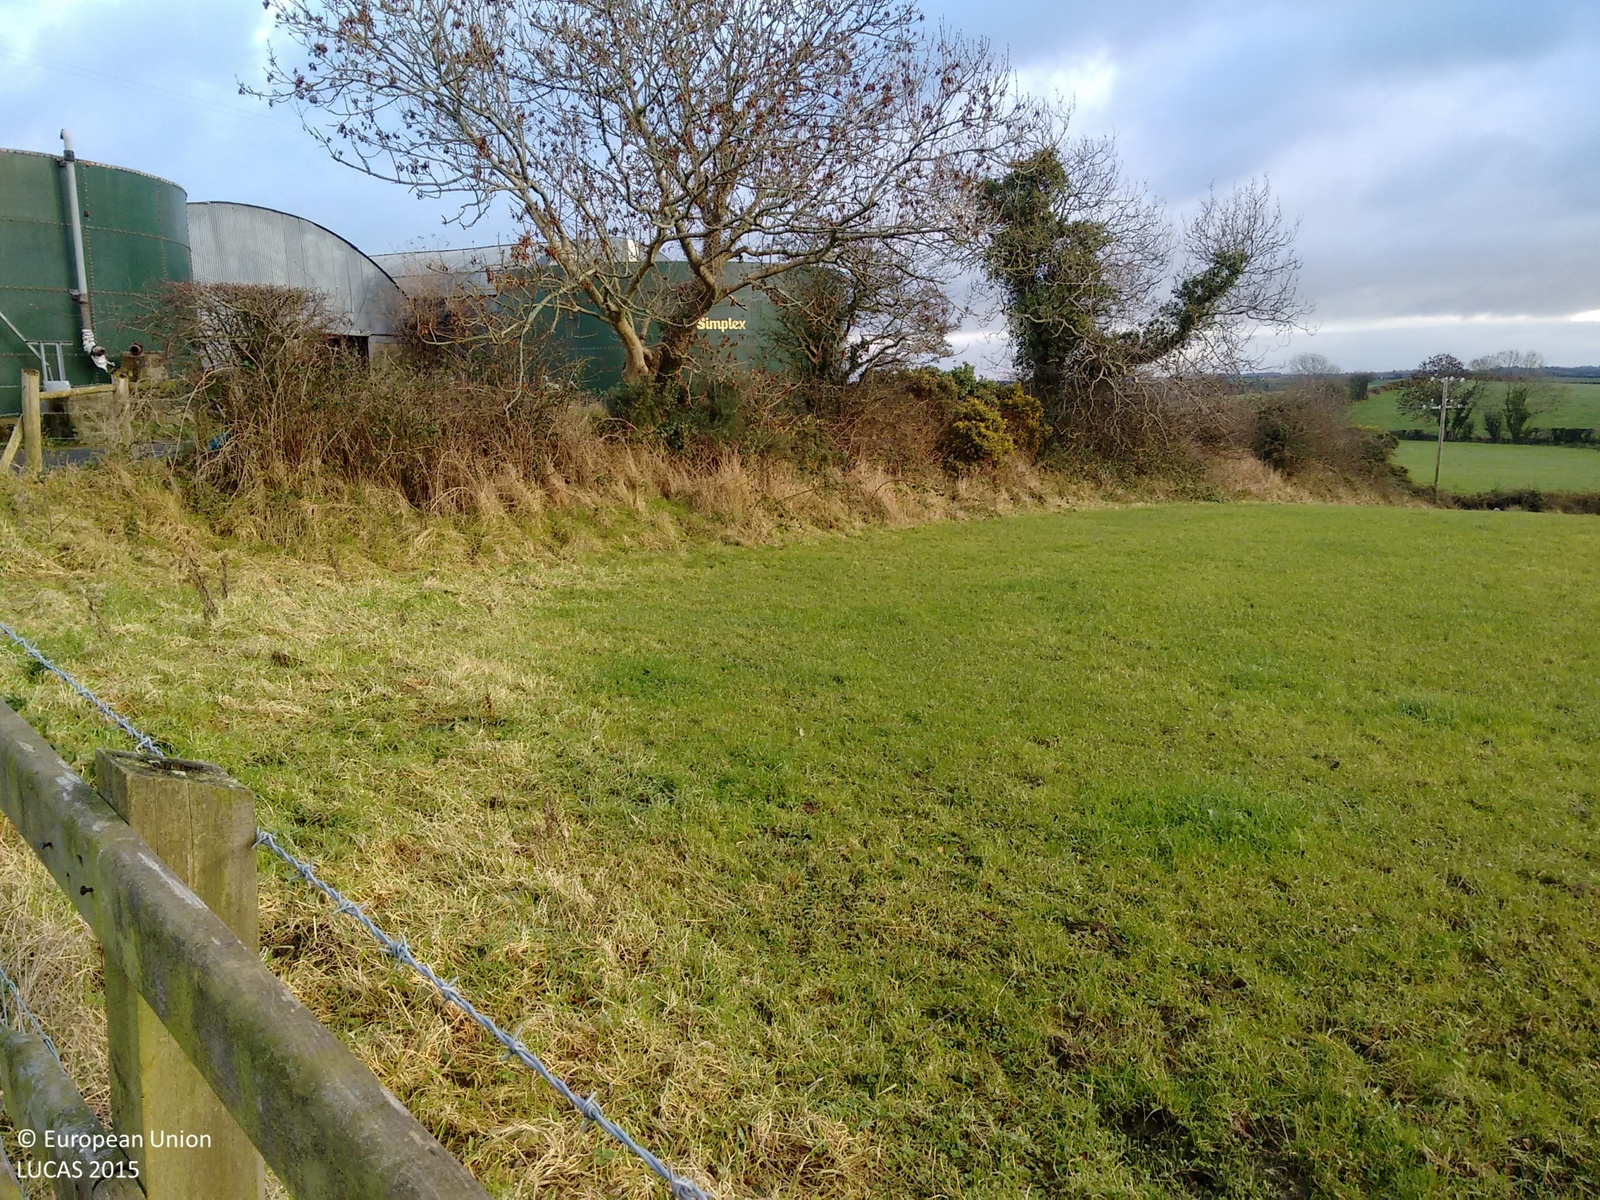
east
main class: Grassland
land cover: Grassland without tree/shrub cover
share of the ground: > 75 %
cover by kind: herbaceous plants 100 %
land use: Agriculture (excluding fallow land and kitchen gardens)
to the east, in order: Grassland without tree/shrub cover; Electric lines; Abandoned hedges; Grassland without tree/shrub cover; Abandoned hedges; Grassland without tree/shrub cover
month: November
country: GB
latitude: 54.5940
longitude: -5.6546
